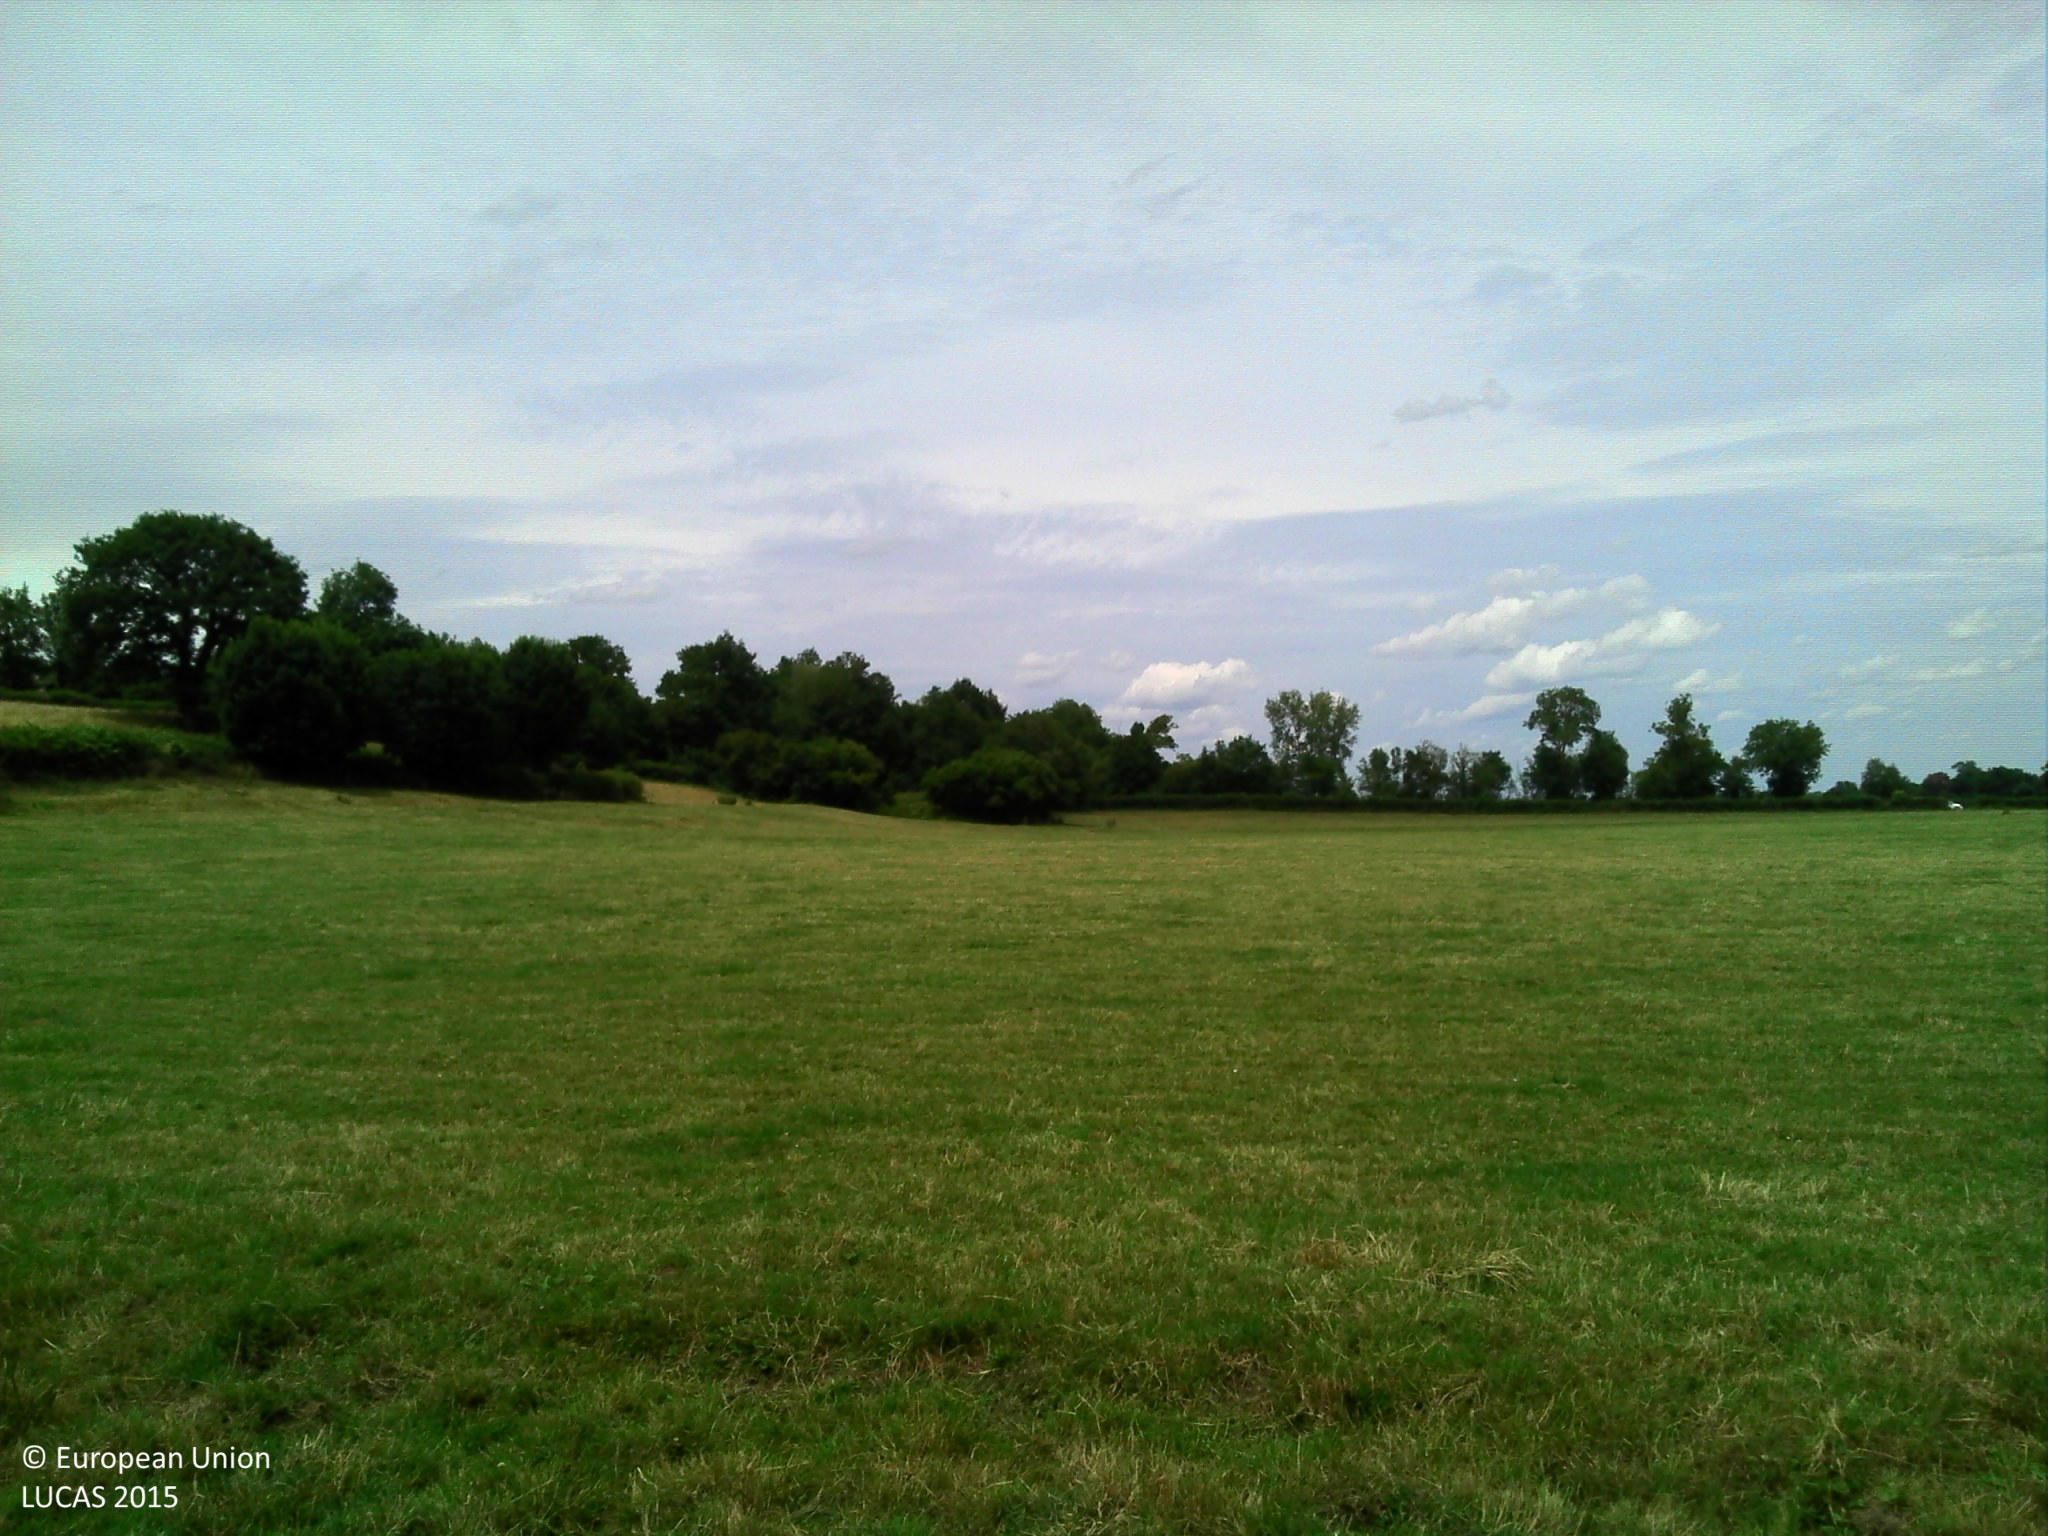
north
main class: Grassland
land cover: Grassland without tree/shrub cover
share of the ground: > 75 %
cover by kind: herbaceous plants 100 %
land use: Agriculture (excluding fallow land and kitchen gardens)
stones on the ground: < 10 %
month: June
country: FR
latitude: 46.4495
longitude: 3.3201
